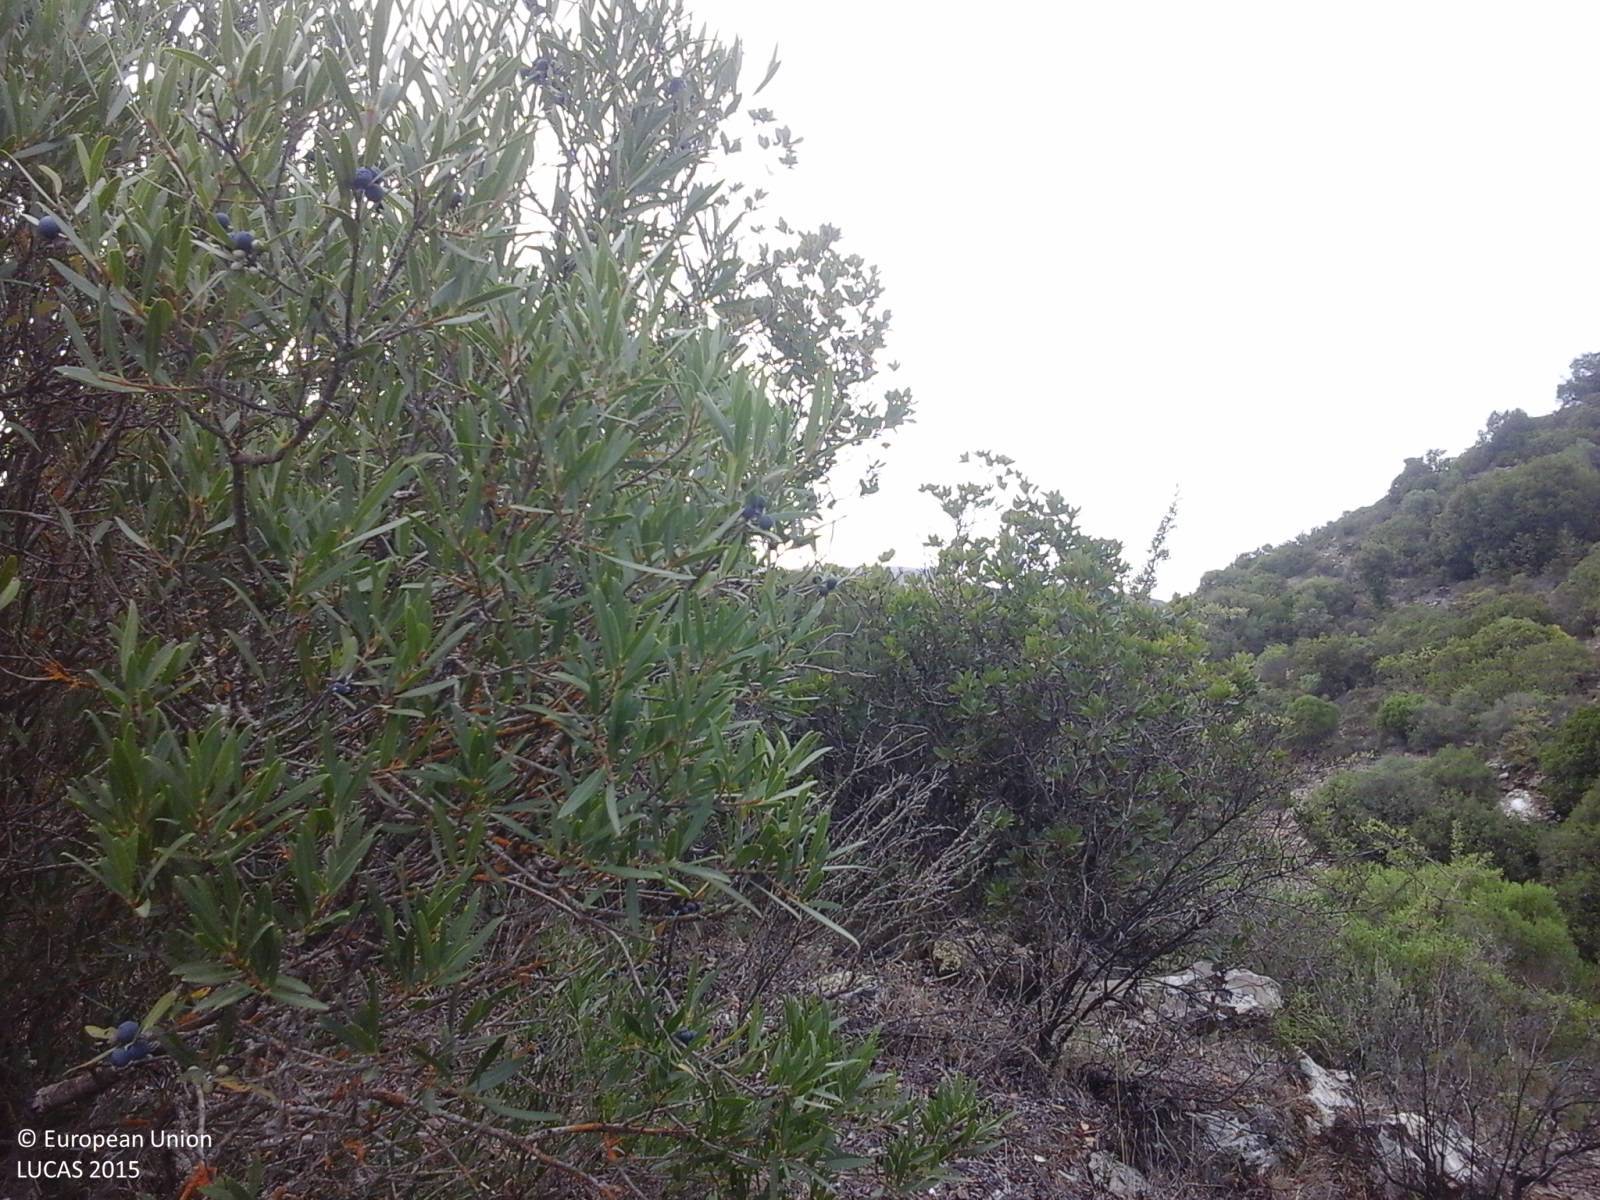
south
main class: Shrubland
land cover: Shrubland without tree cover
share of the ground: > 75 %
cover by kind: shrubs 55 %, herbaceous plants 25 %, consolidated bare surface 10 %, unconsolidated bare surface 10 %
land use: Semi-natural and natural areas not in use
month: September
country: IT
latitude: 39.7587
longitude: 9.4313
